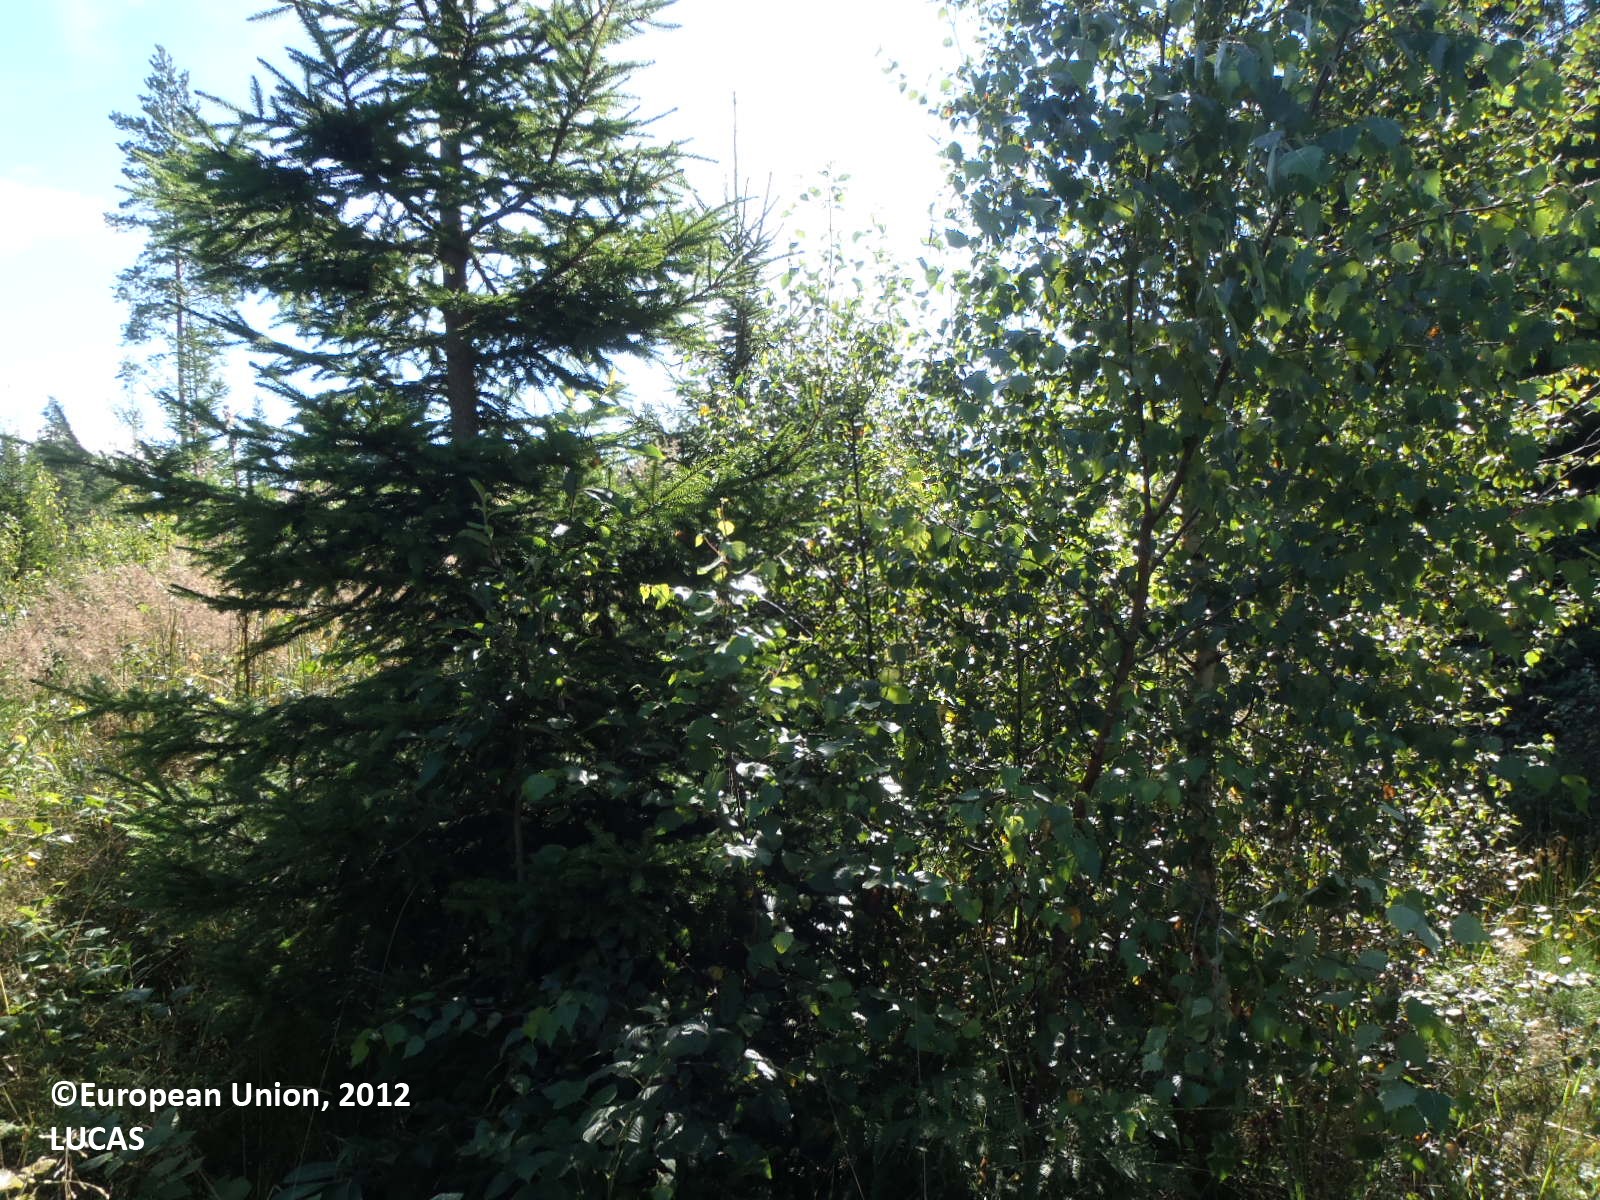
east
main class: Woodland
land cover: Spruce dominated mixed woodland
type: boreal forest
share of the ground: > 75 %
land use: Forestry
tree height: > 5 m
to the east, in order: Spruce dominated mixed woodland; Ditches and canals; Spruce dominated mixed woodland; Pine dominated mixed woodland; Pine dominated coniferous woodland
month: August
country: FI
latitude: 60.2455
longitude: 22.2616
